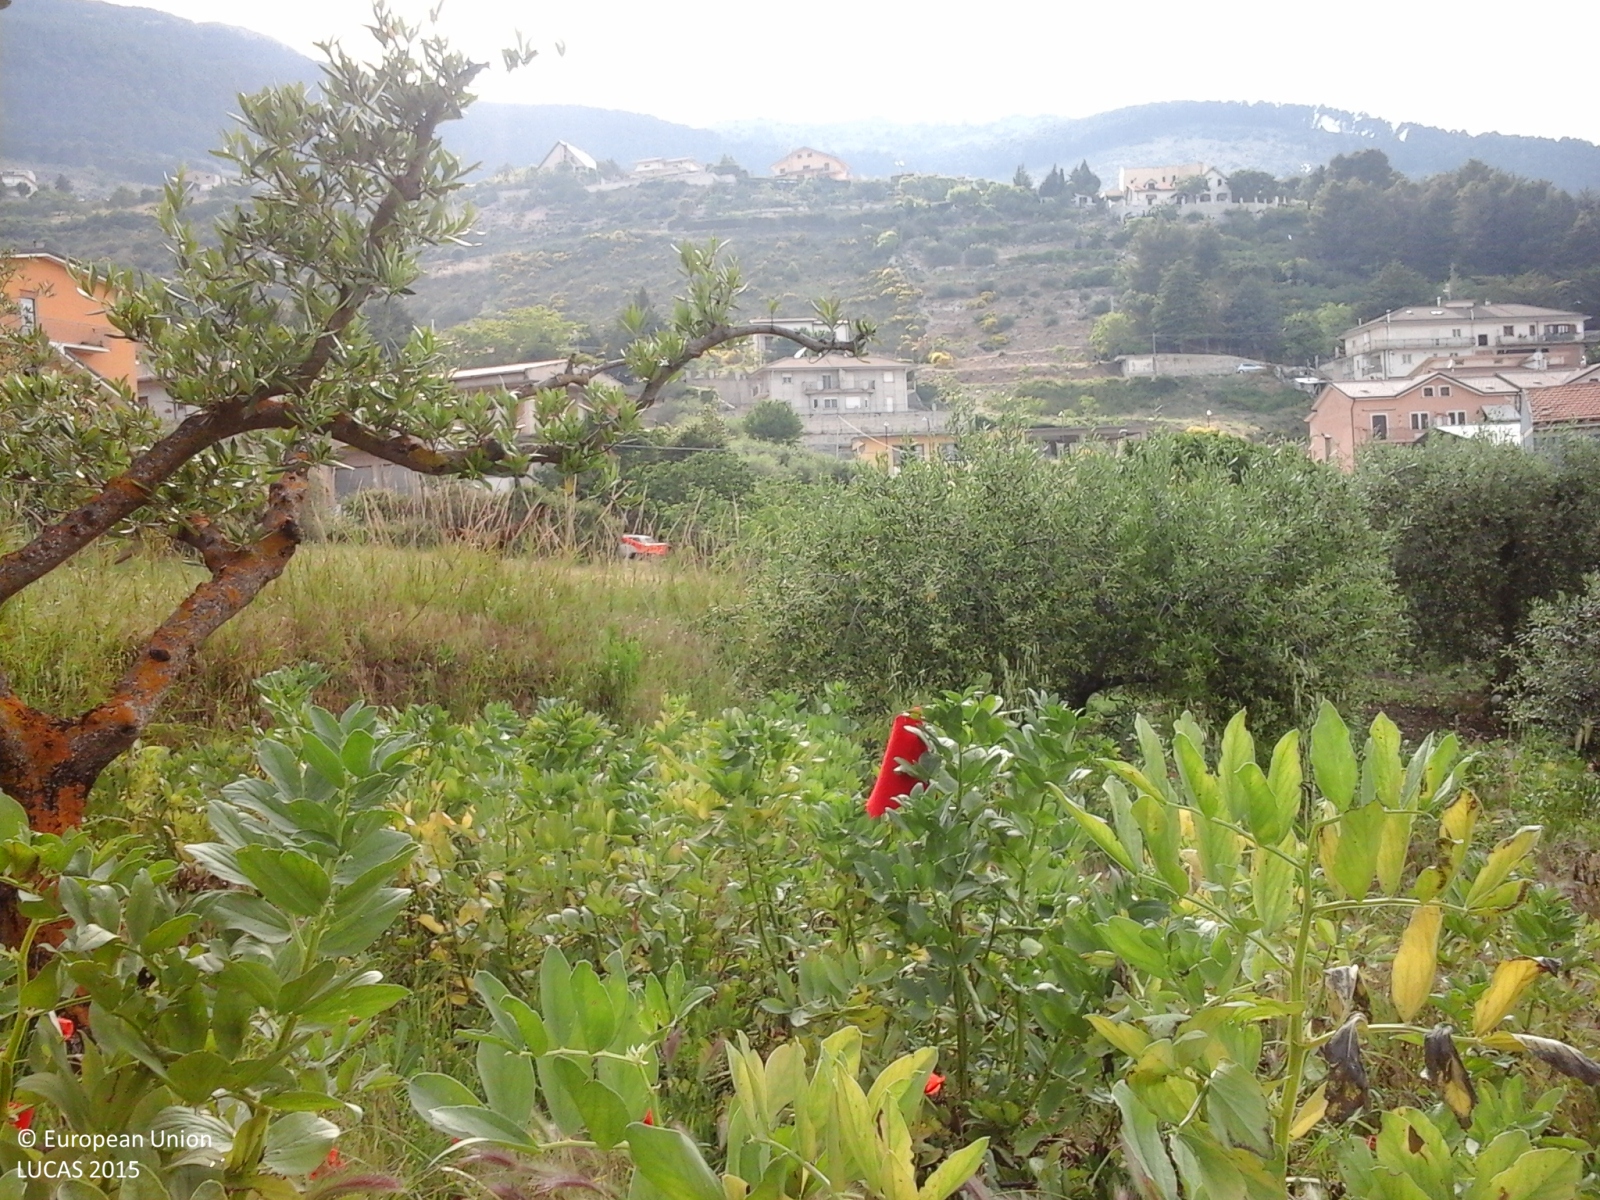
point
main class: Cropland
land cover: Olive groves
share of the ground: 50 - 75 %
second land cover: Other fresh vegetables
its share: > 75 %
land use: Agriculture (excluding fallow land and kitchen gardens)
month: June
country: IT
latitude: 37.6236
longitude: 13.6326
